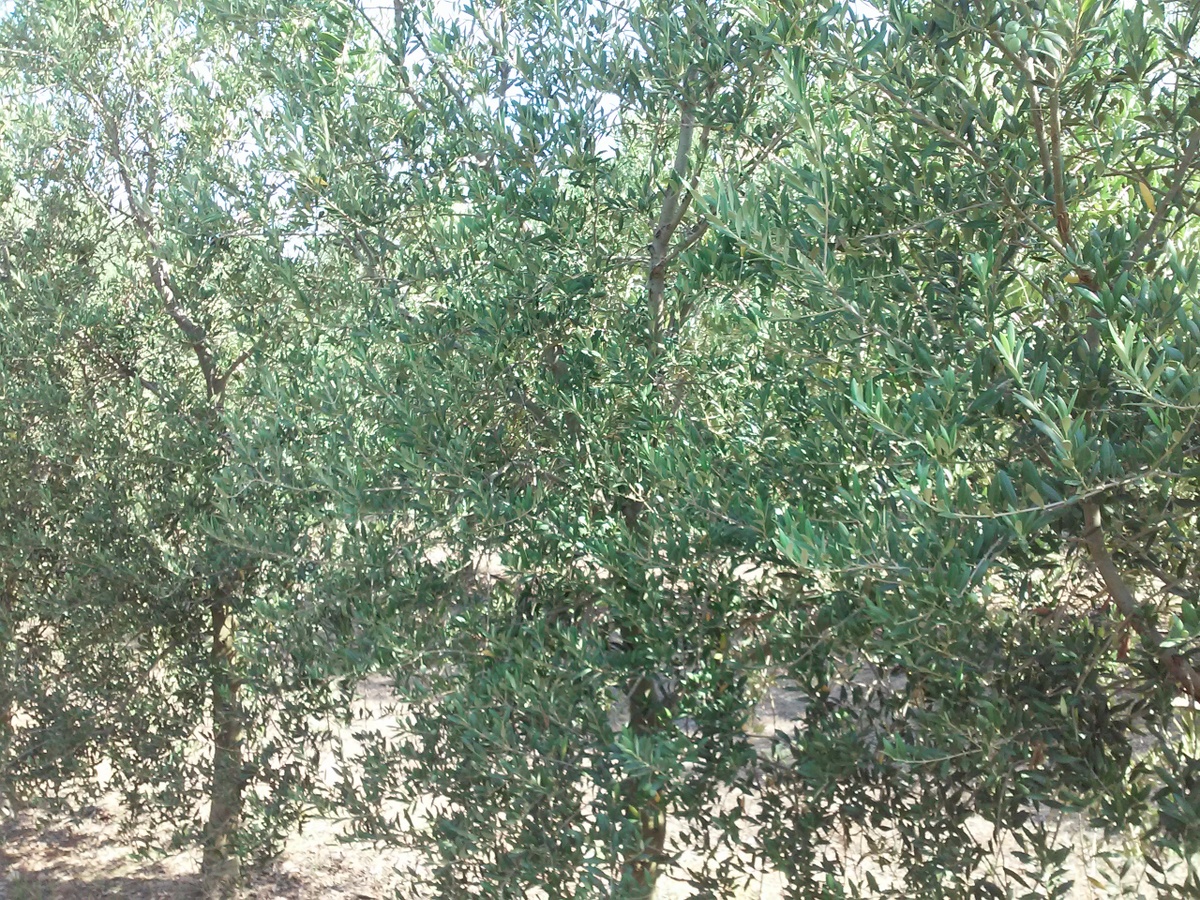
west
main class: Cropland
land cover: Olive groves
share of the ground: 10 - 25 %
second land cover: Other bare soil
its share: > 75 %
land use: Agriculture (excluding fallow land and kitchen gardens)
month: August
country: ES
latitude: 41.0911
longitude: 0.6228
